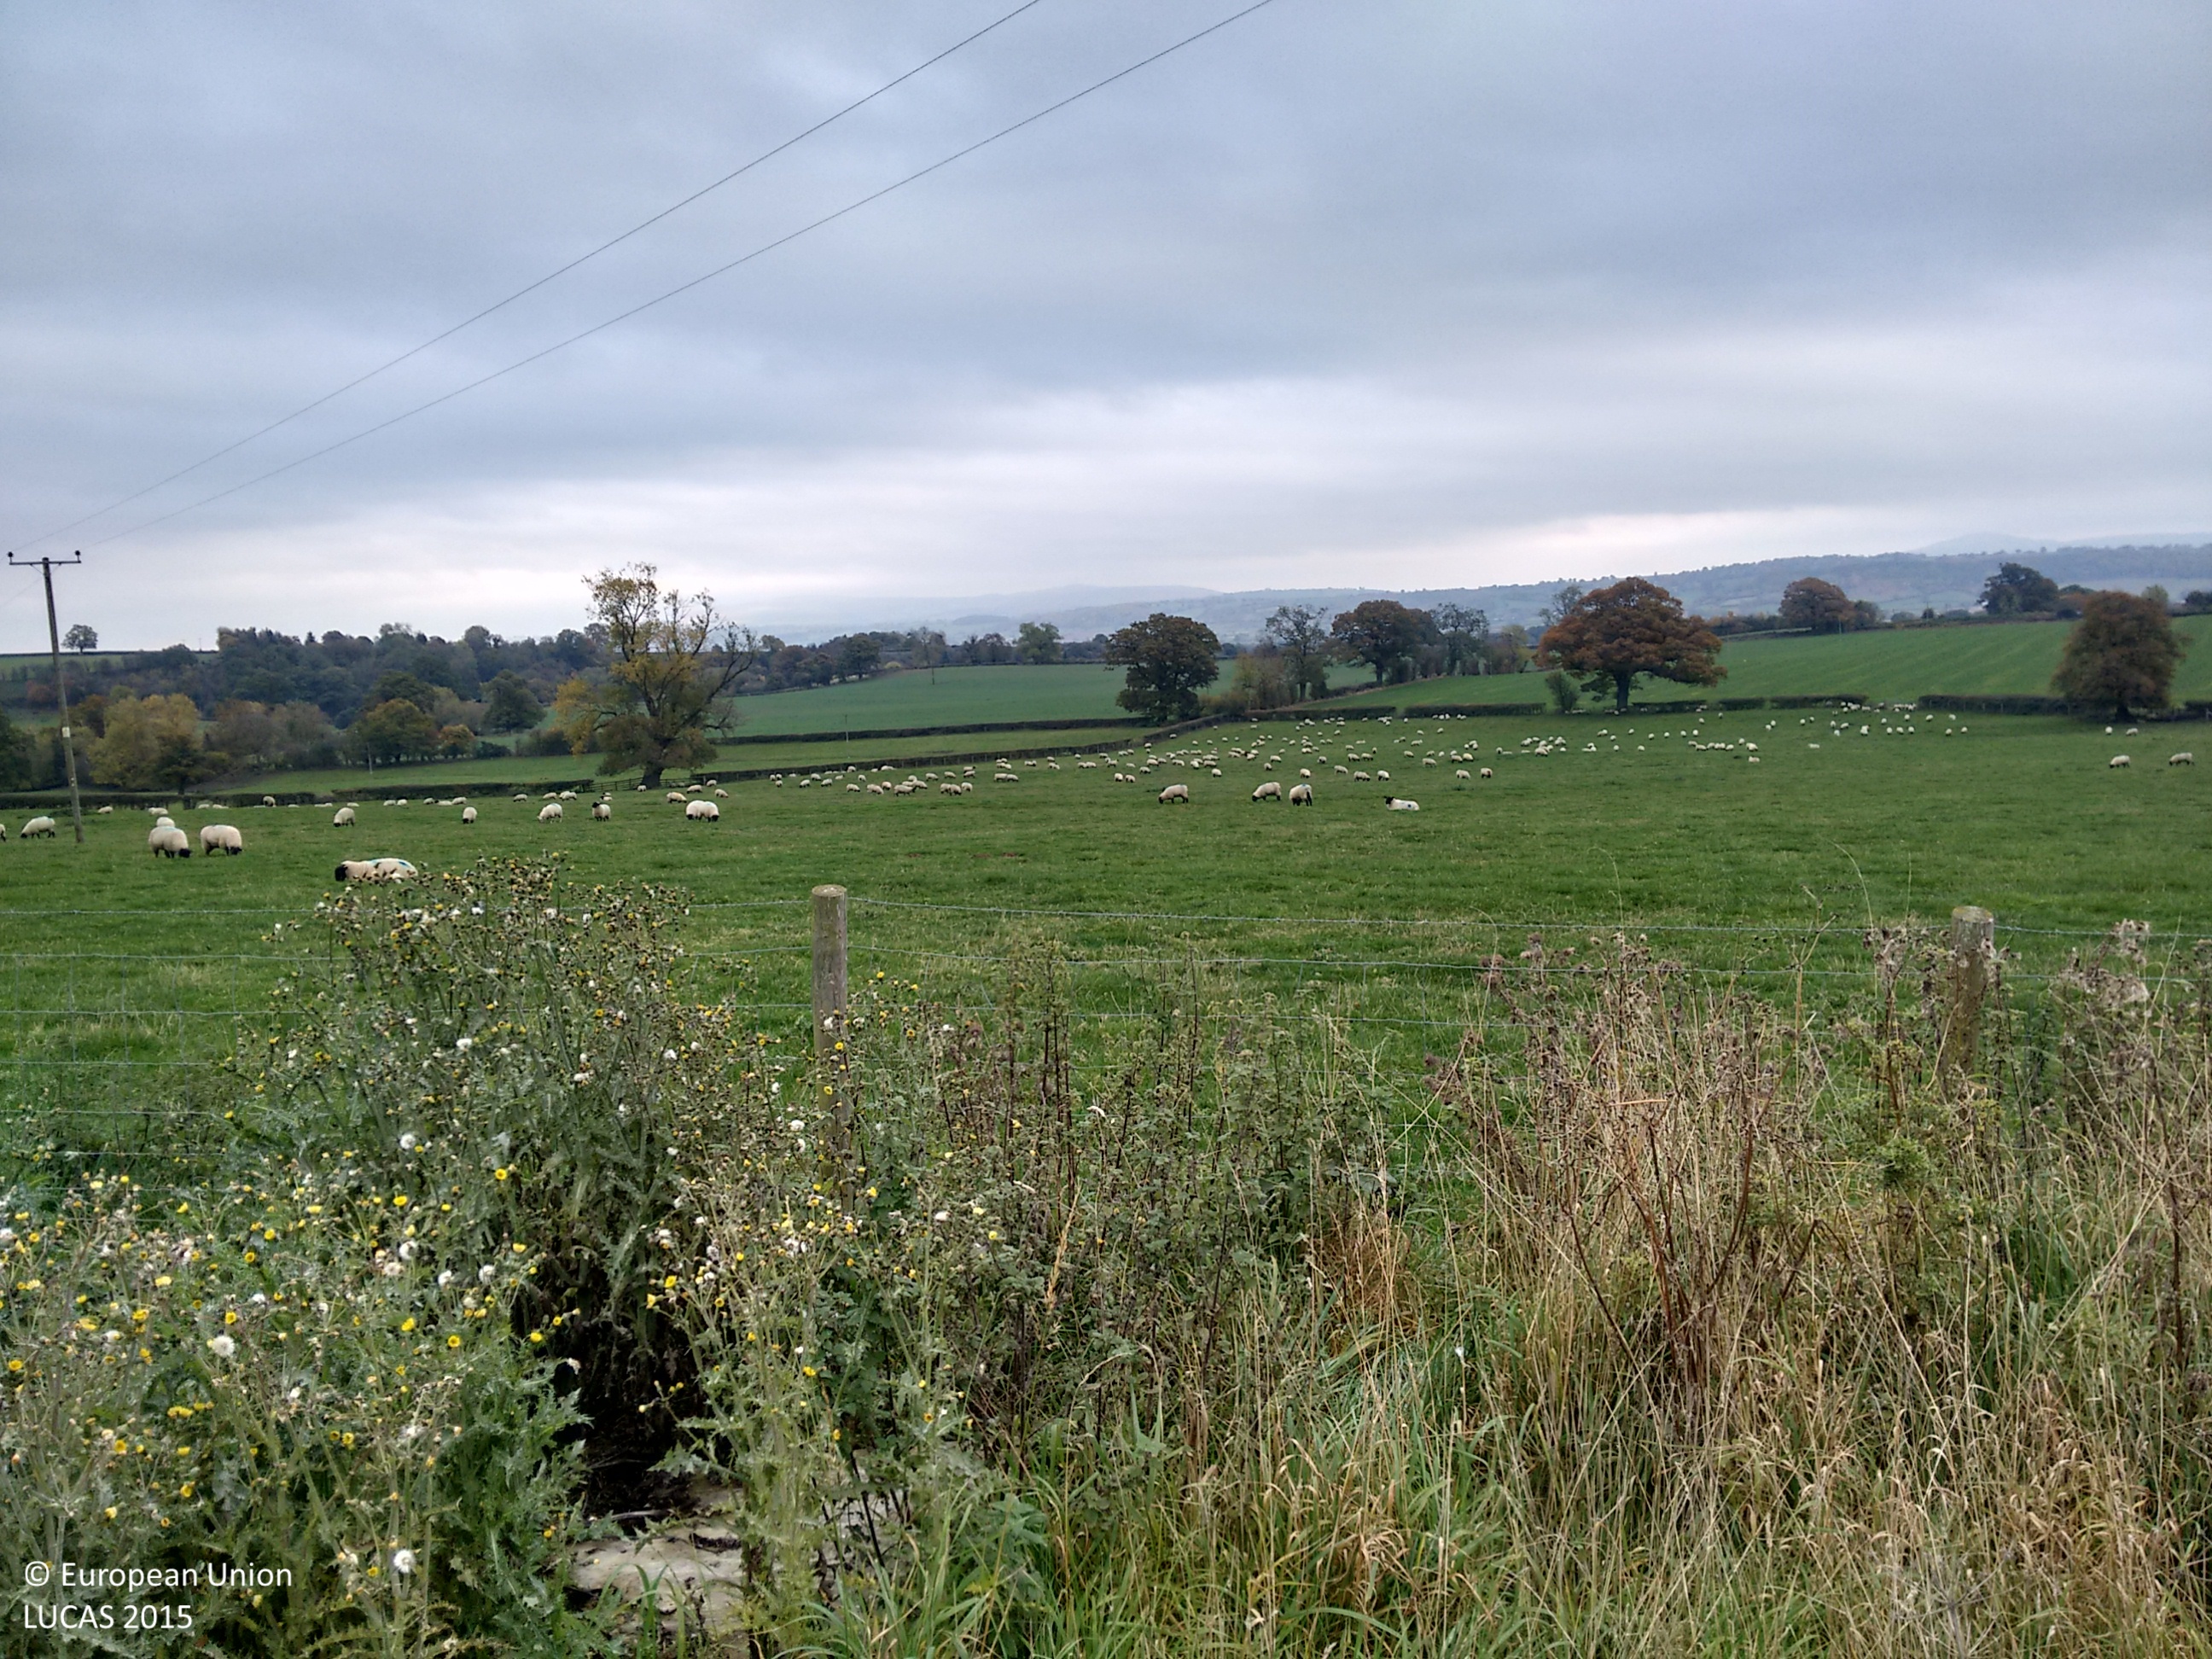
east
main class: Grassland
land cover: Grassland without tree/shrub cover
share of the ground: > 75 %
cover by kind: herbaceous plants 100 %
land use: Agriculture (excluding fallow land and kitchen gardens)
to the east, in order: Grassland without tree/shrub cover; Managed hedges; Fences; Managed hedges; Grass margins; Arable land (only in case pi); Electric lines; Arable land (only in case pi)
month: October
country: GB
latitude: 52.4284
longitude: -2.7928
